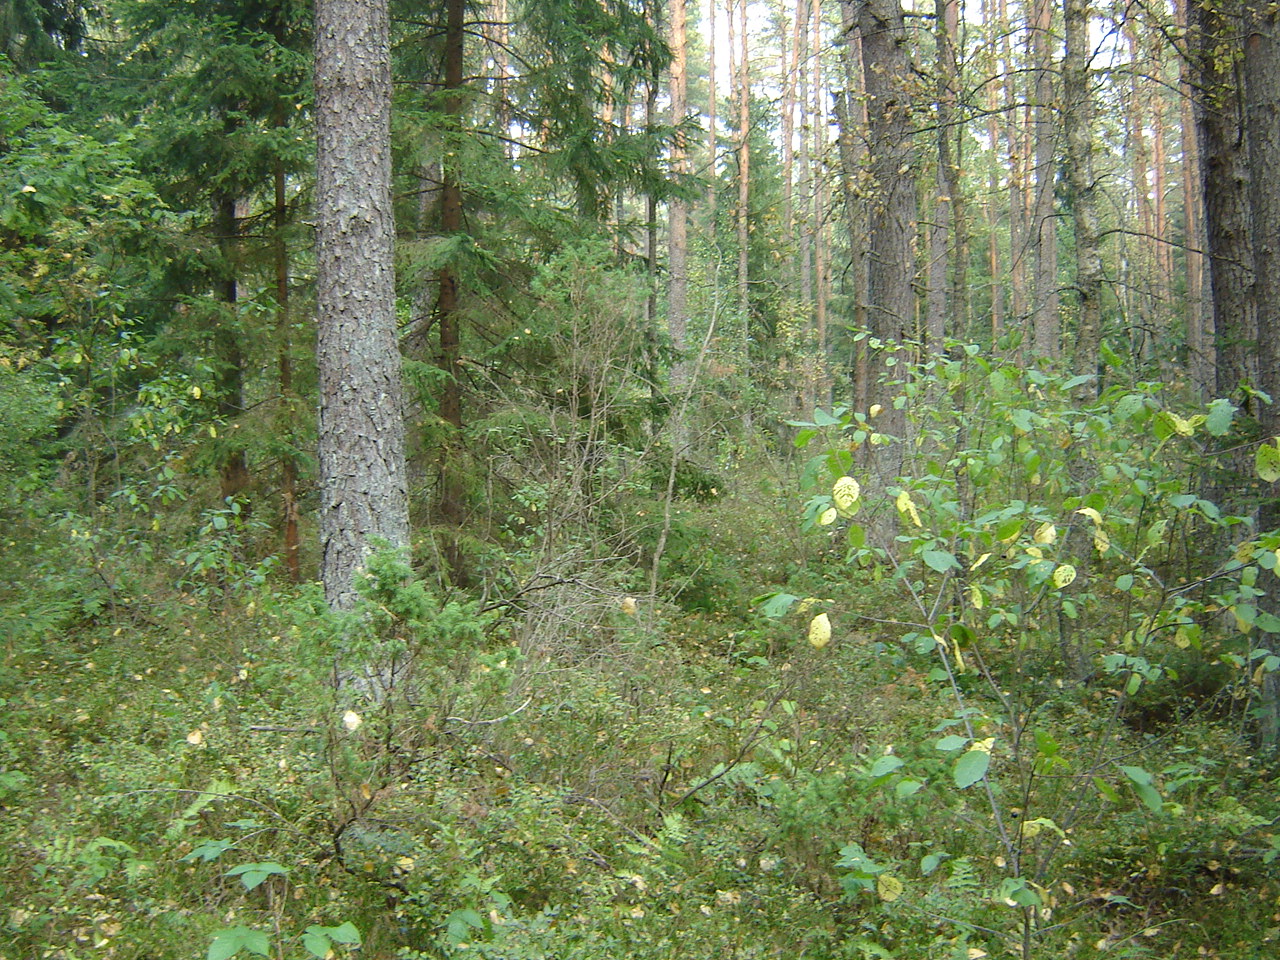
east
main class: Woodland
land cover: Pine dominated coniferous woodland
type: hemiboreal forest and nemoral coniferous forest and mixed broadleaved-coniferous forest
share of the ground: > 75 %
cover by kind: coniferous forest trees 60 %, broadleaved forest trees 20 %, shrubs 10 %, lichens and mosses 10 %
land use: Forestry
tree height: > 5 m
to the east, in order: Pine dominated coniferous woodland; Spruce dominated coniferous woodland; Pine dominated coniferous woodland; Other coniferous woodland; Tracks
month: September
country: LT
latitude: 54.4781
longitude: 24.8182
